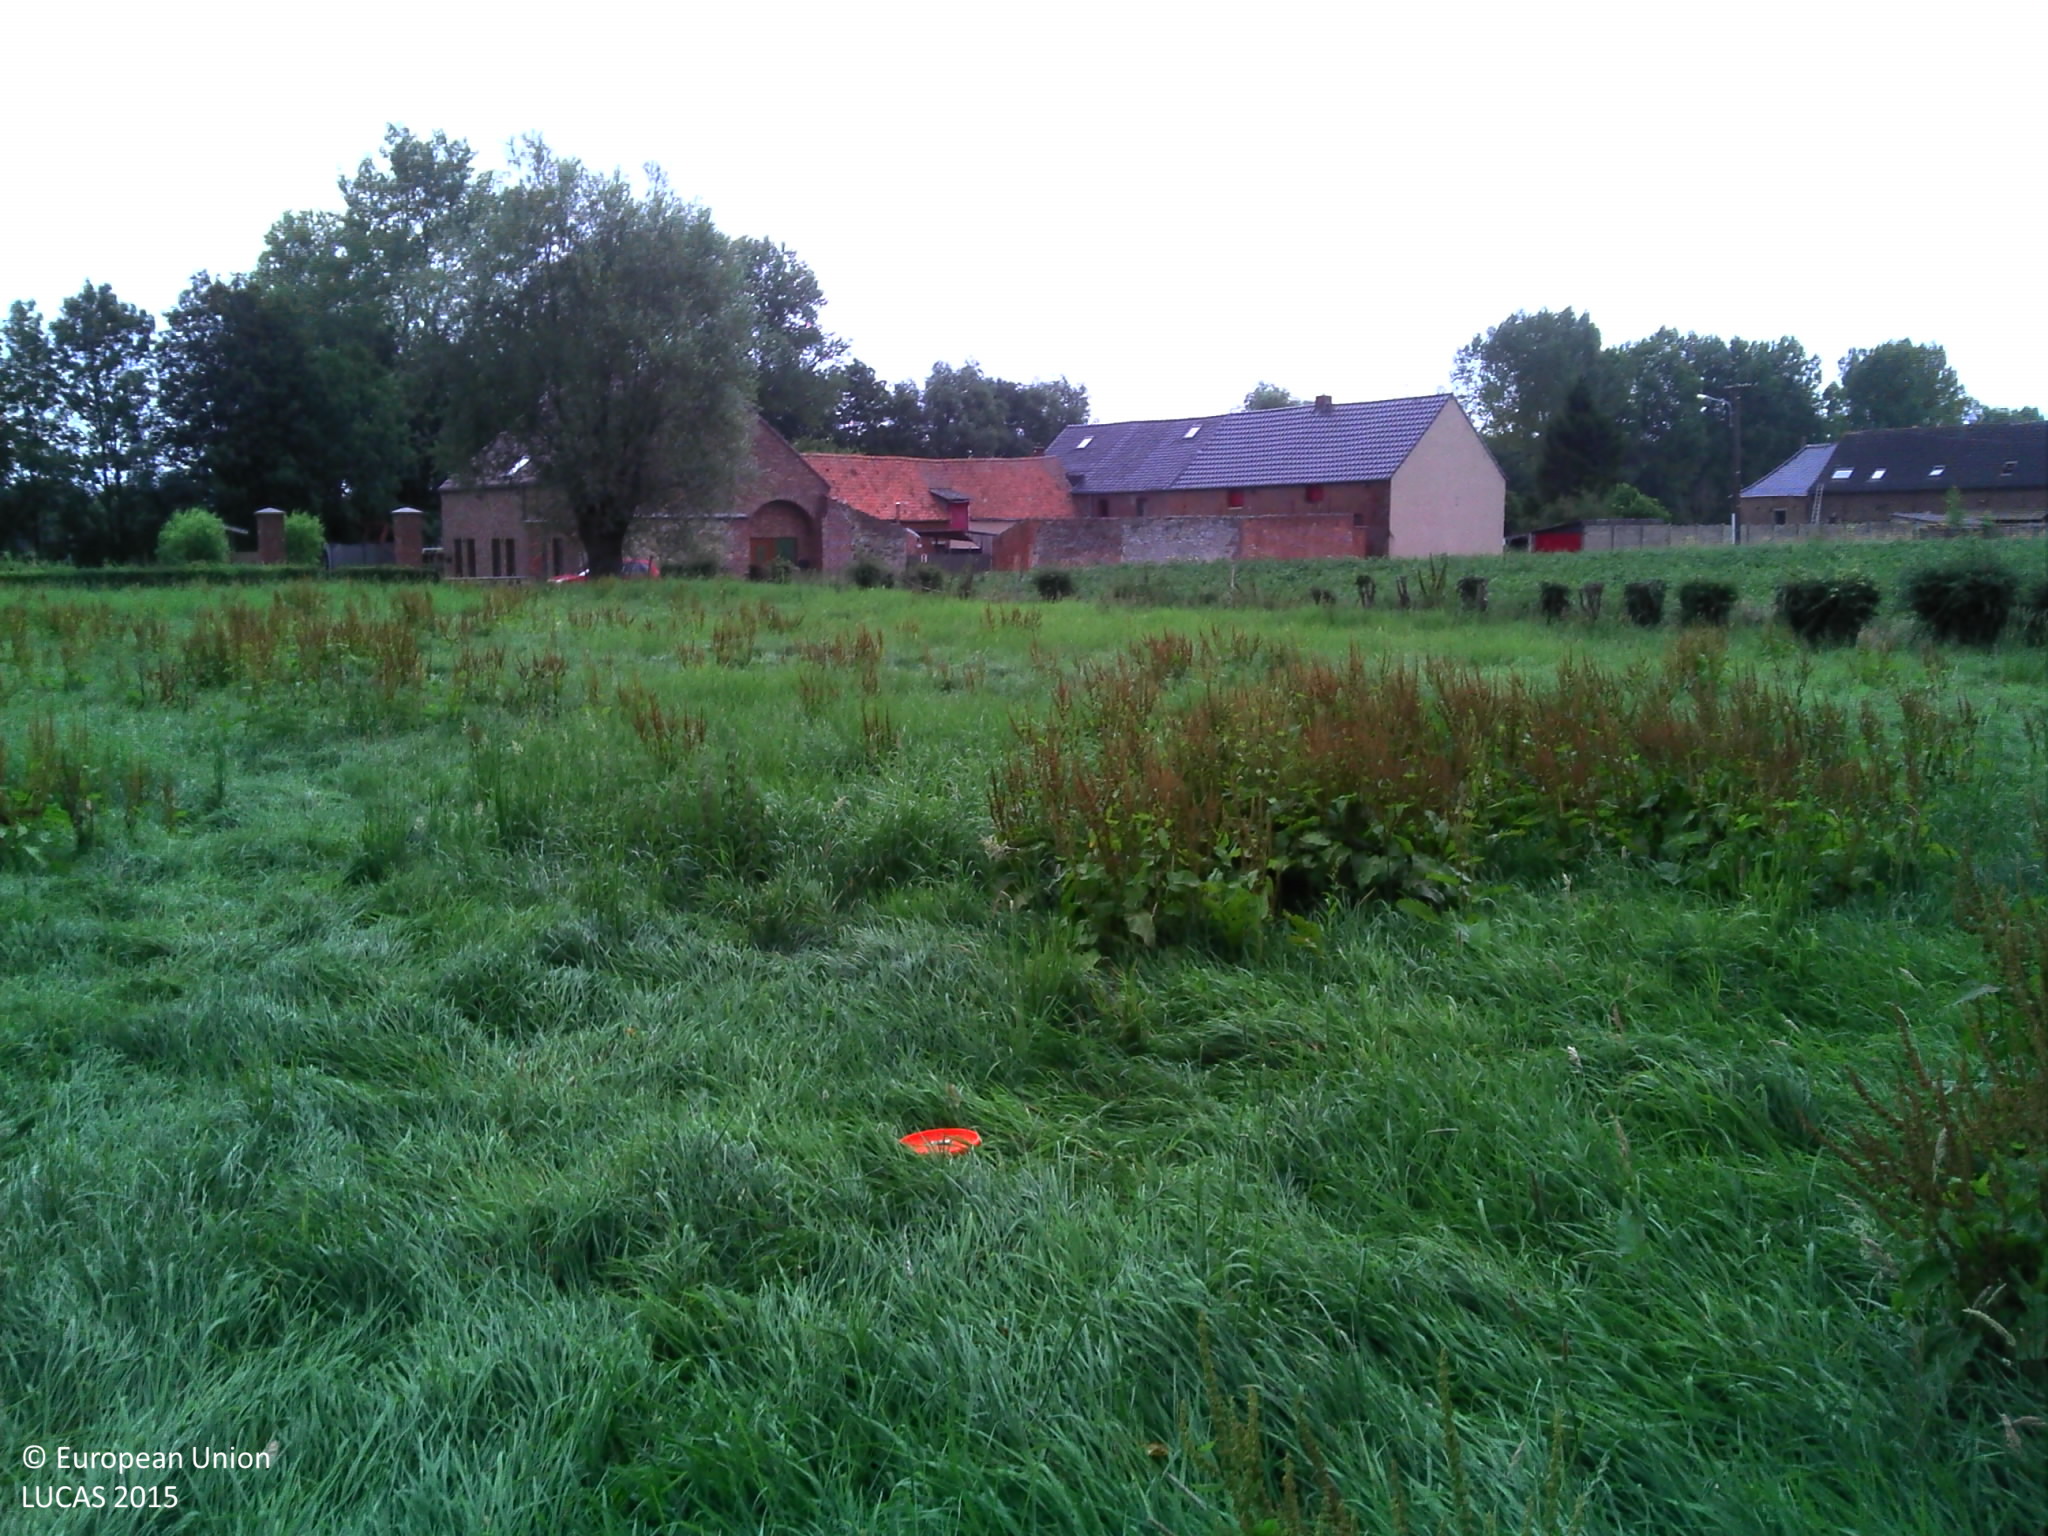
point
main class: Grassland
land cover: Grassland without tree/shrub cover
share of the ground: > 75 %
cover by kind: herbaceous plants 100 %
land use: Agriculture (excluding fallow land and kitchen gardens)
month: August
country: BE
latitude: 50.6653
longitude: 3.8108
